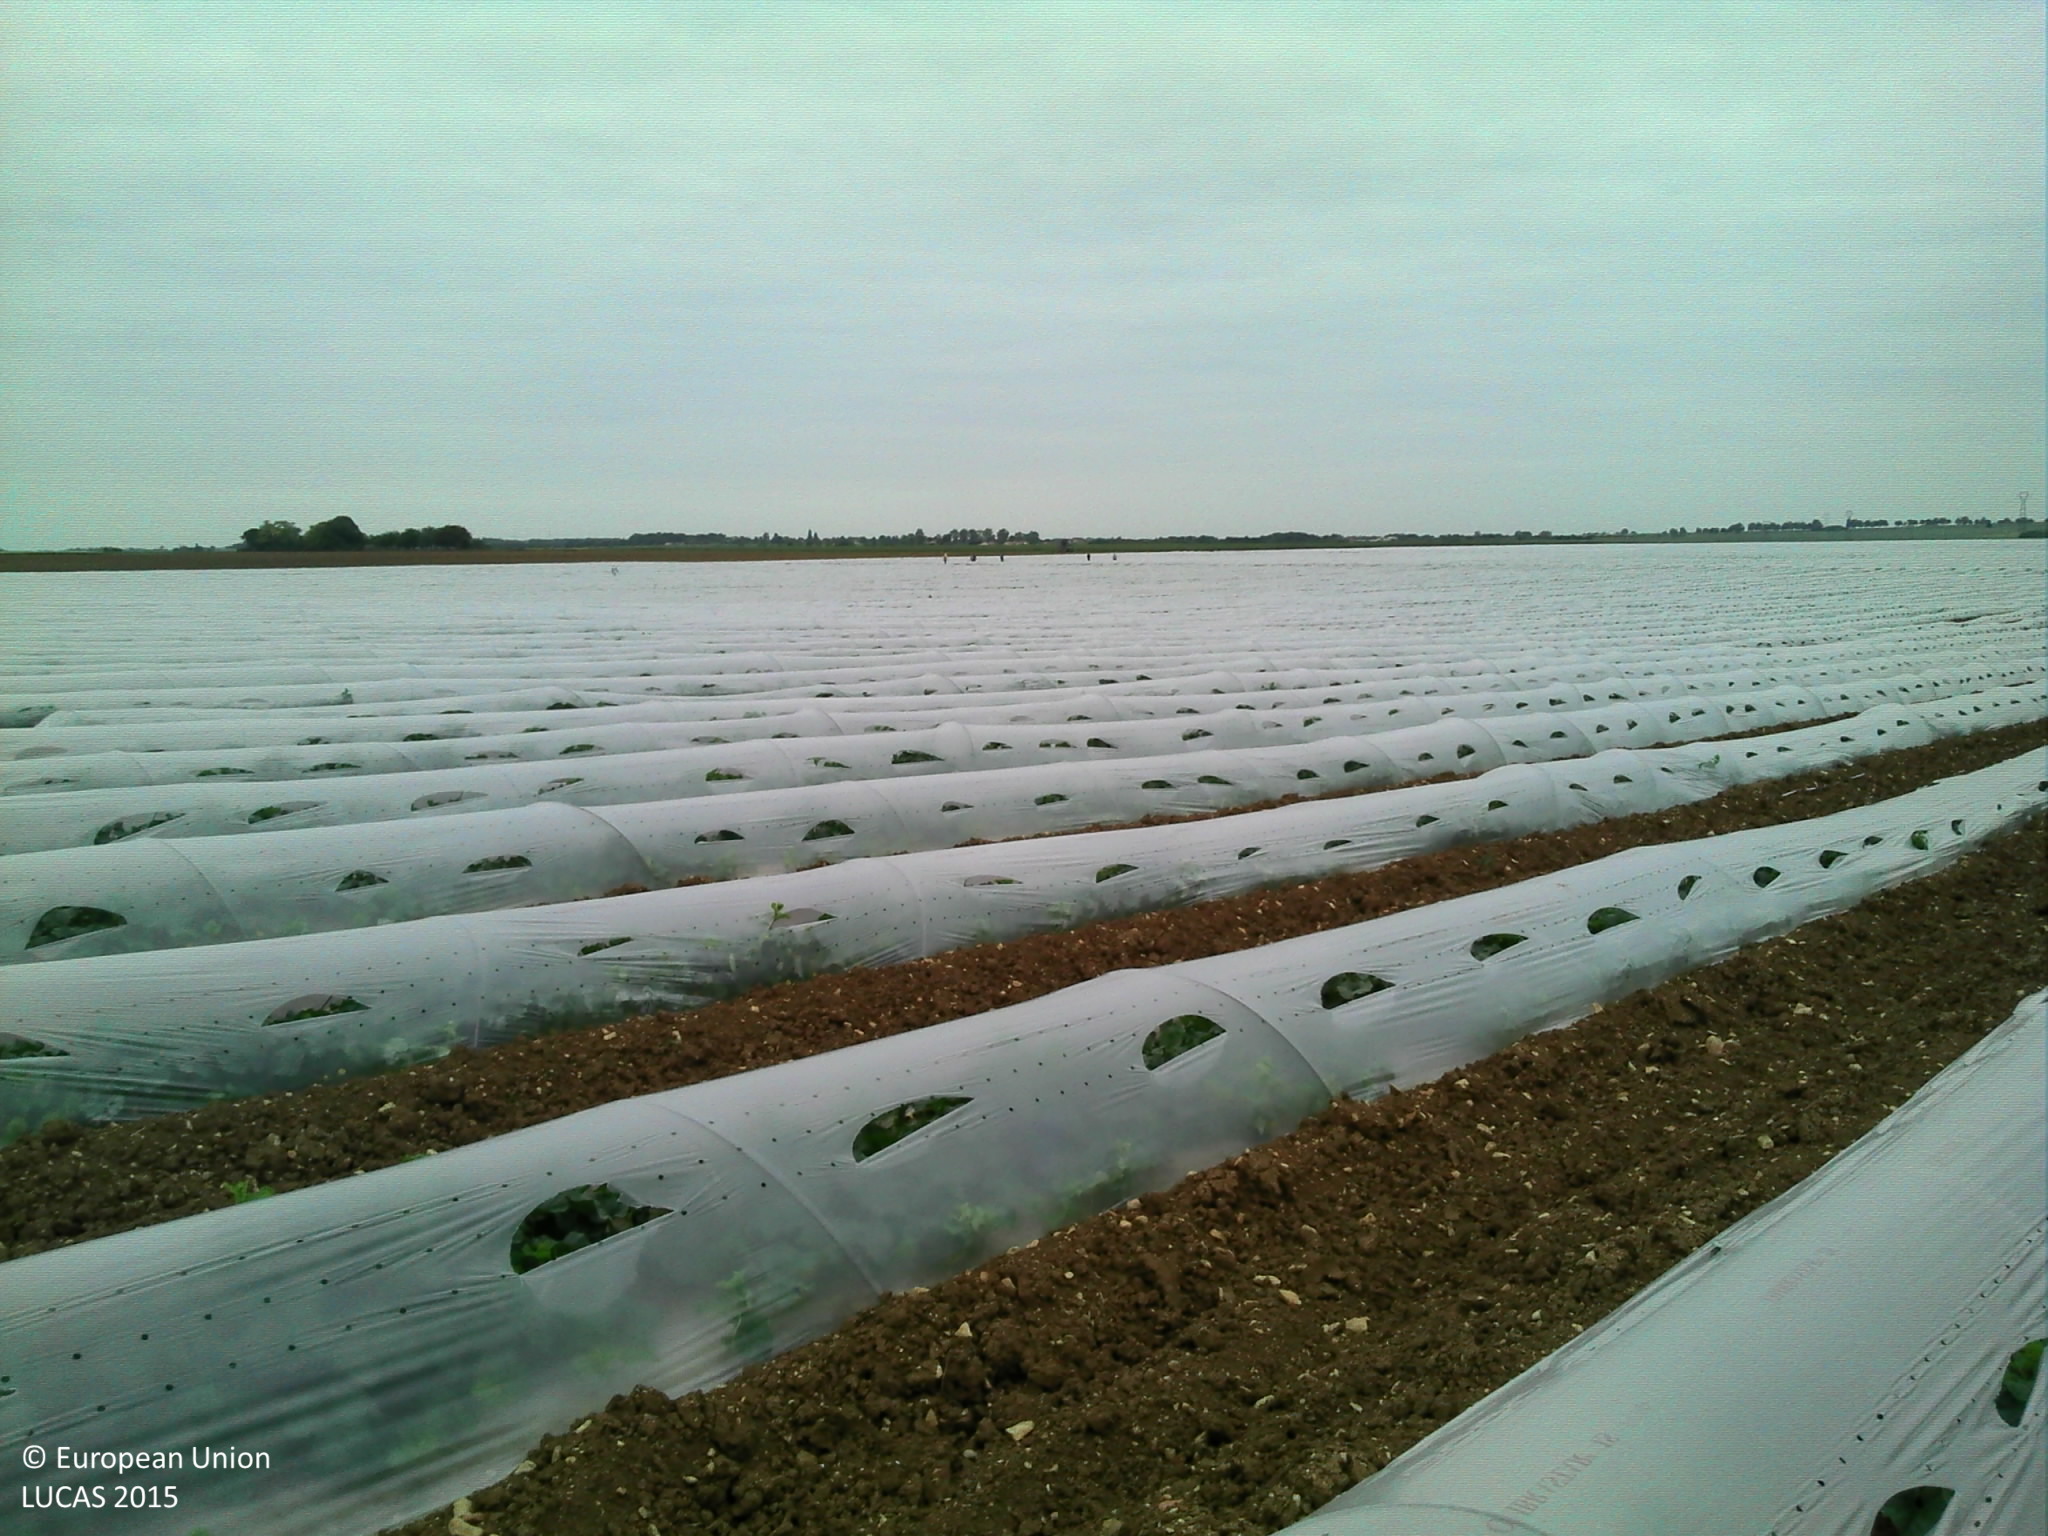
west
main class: Cropland
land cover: Other fresh vegetables
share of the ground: 50 - 75 %
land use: Agriculture (excluding fallow land and kitchen gardens)
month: May
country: FR
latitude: 46.7038
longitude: 0.2619
